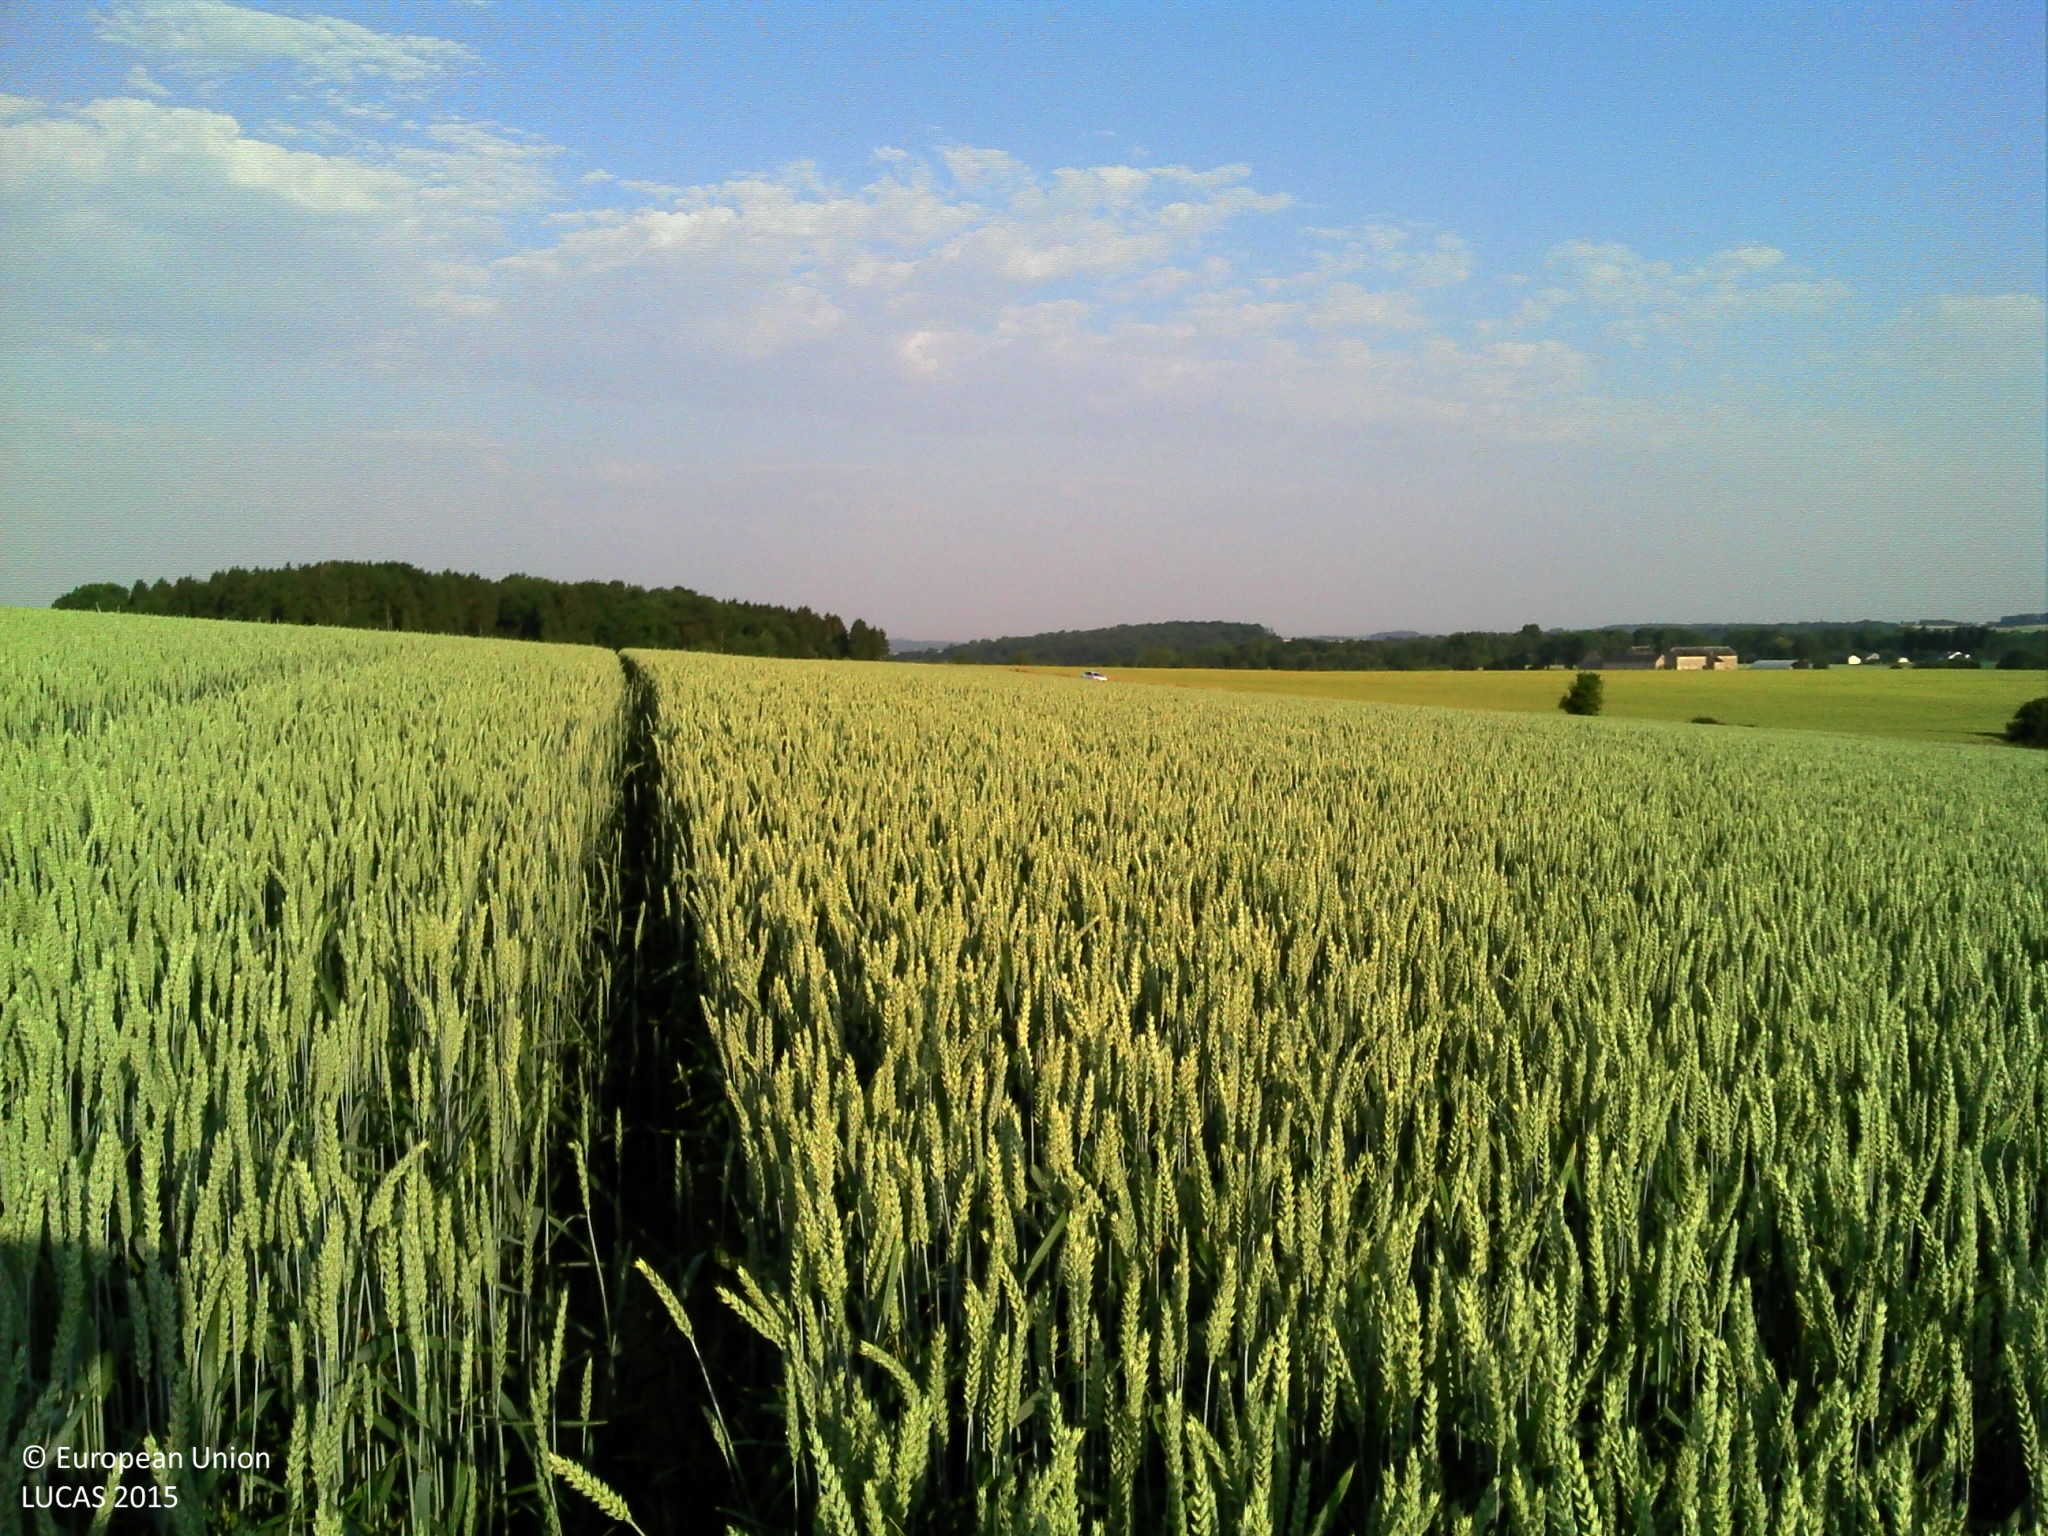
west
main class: Cropland
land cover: Common wheat
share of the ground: > 75 %
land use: Agriculture (excluding fallow land and kitchen gardens)
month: July
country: BE
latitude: 50.2148
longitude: 4.9100
